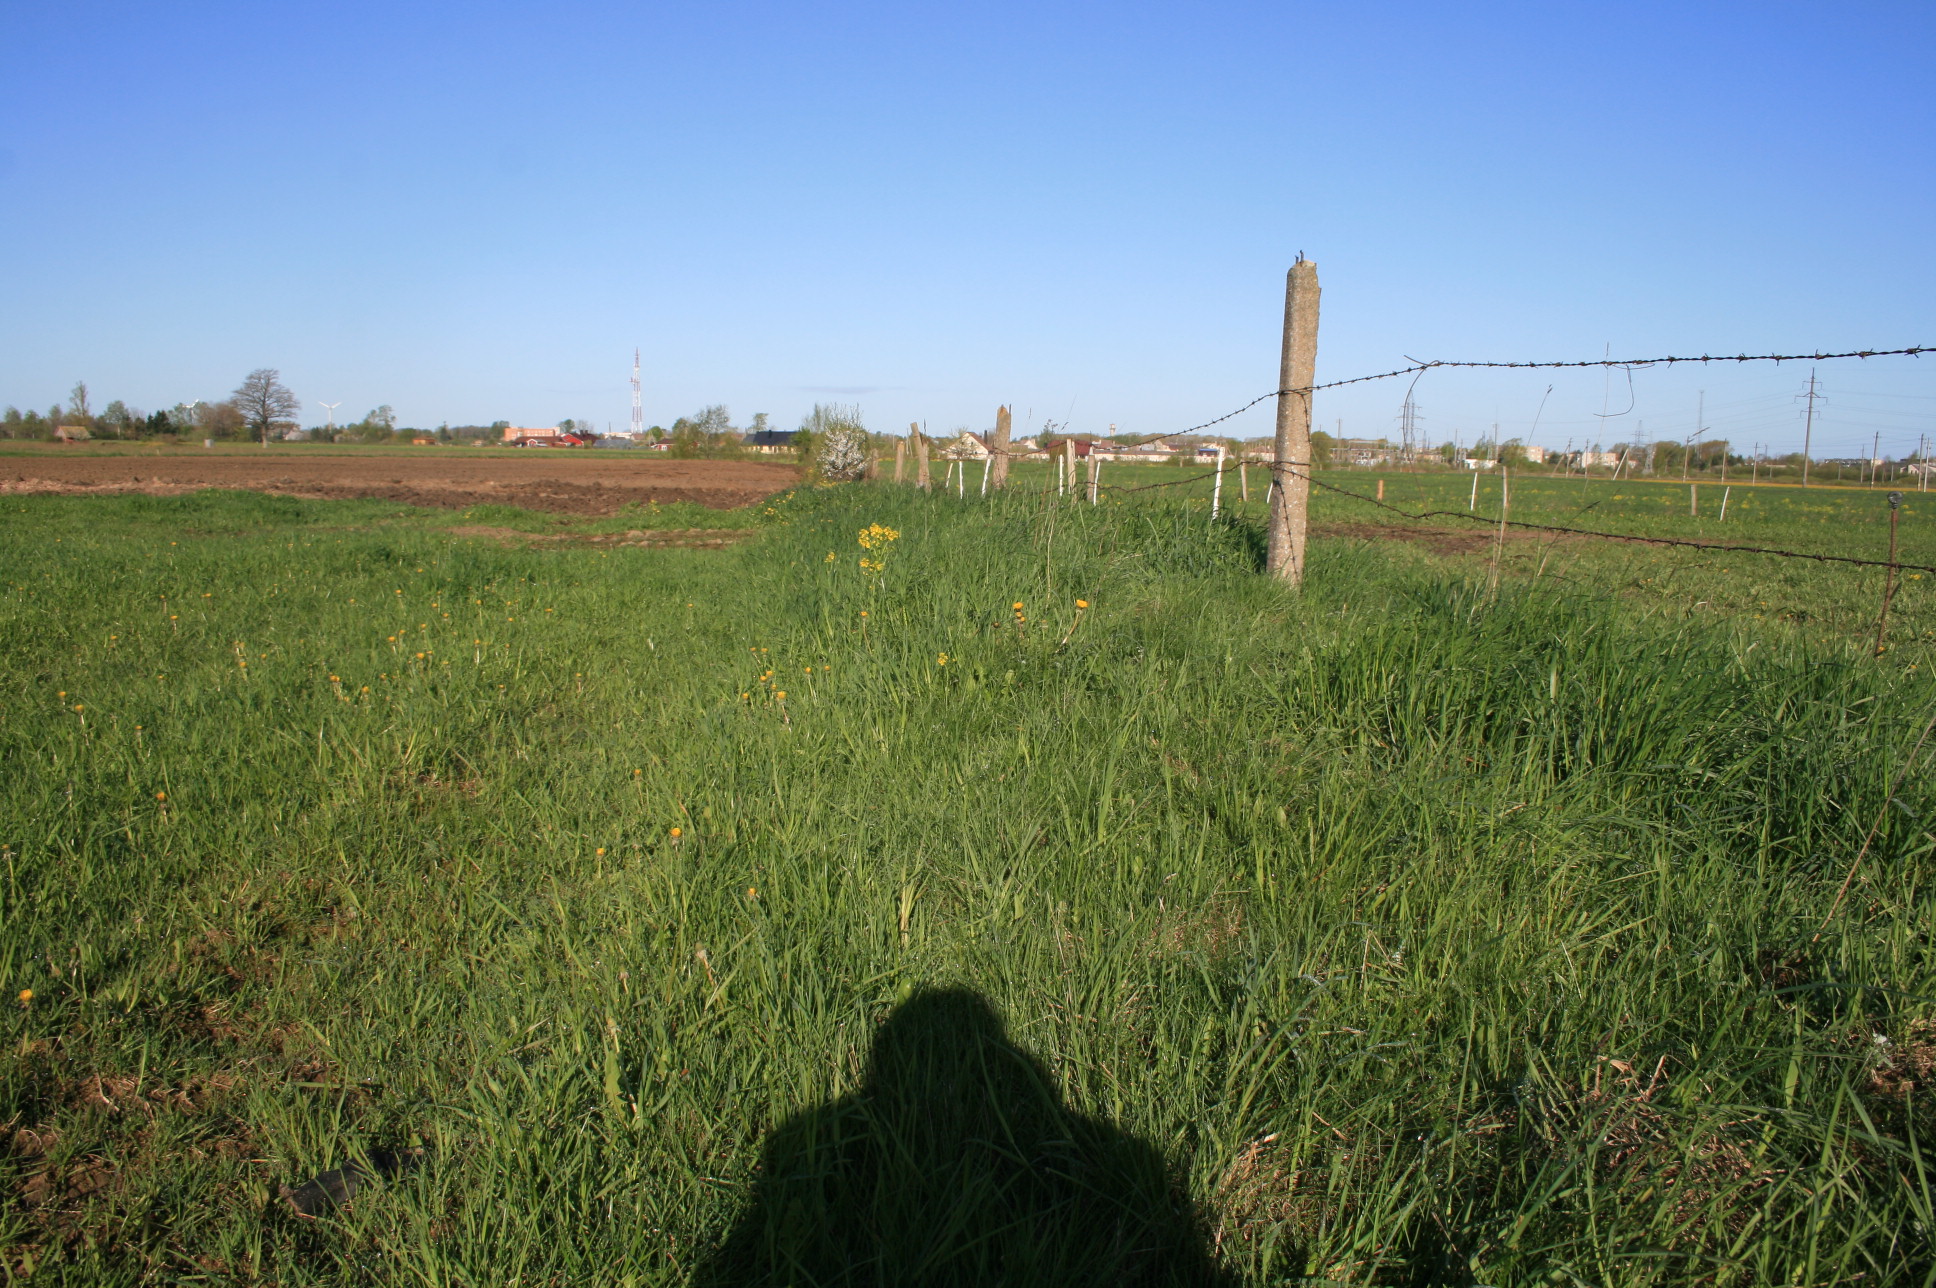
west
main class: Grassland
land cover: Grassland without tree/shrub cover
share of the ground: > 75 %
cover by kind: herbaceous plants 100 %
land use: Agriculture (excluding fallow land and kitchen gardens)
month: May
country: LT
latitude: 56.2638
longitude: 21.5553
